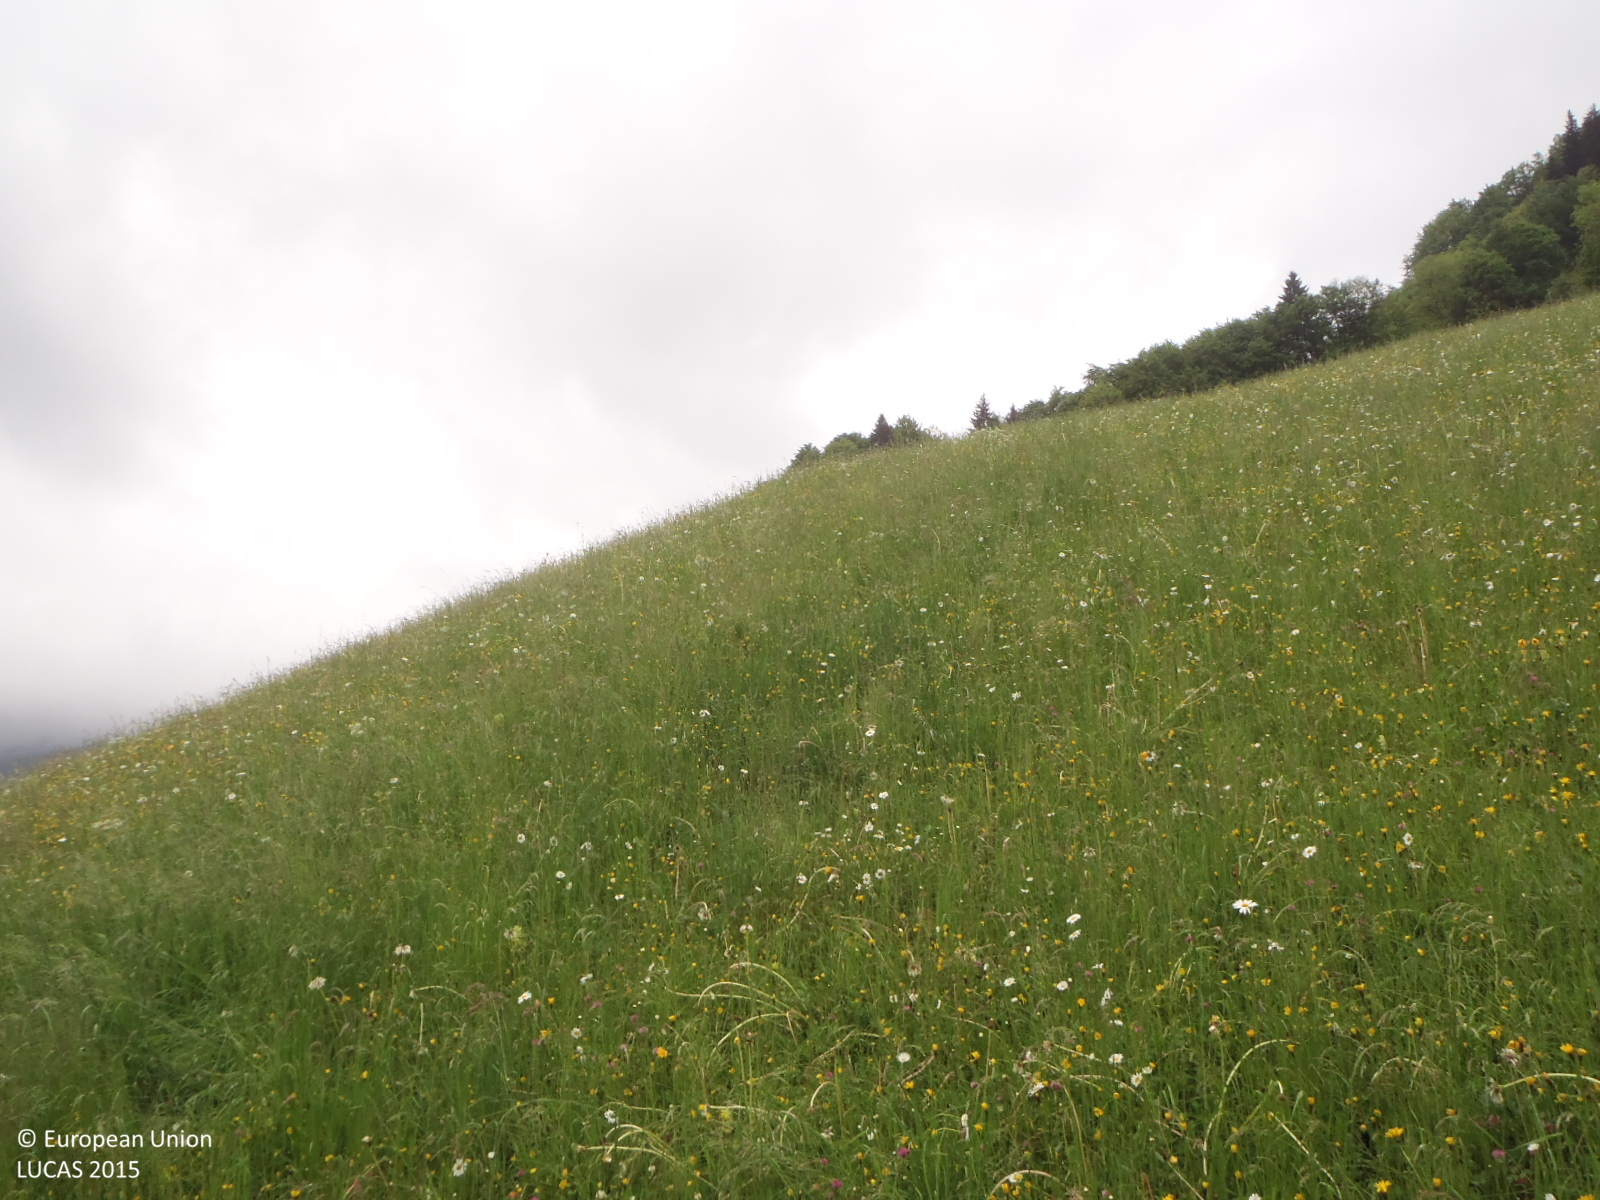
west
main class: Grassland
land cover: Grassland without tree/shrub cover
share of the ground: > 75 %
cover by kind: herbaceous plants 100 %
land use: Agriculture (excluding fallow land and kitchen gardens)
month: May
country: AT
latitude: 47.5590
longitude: 12.7494
